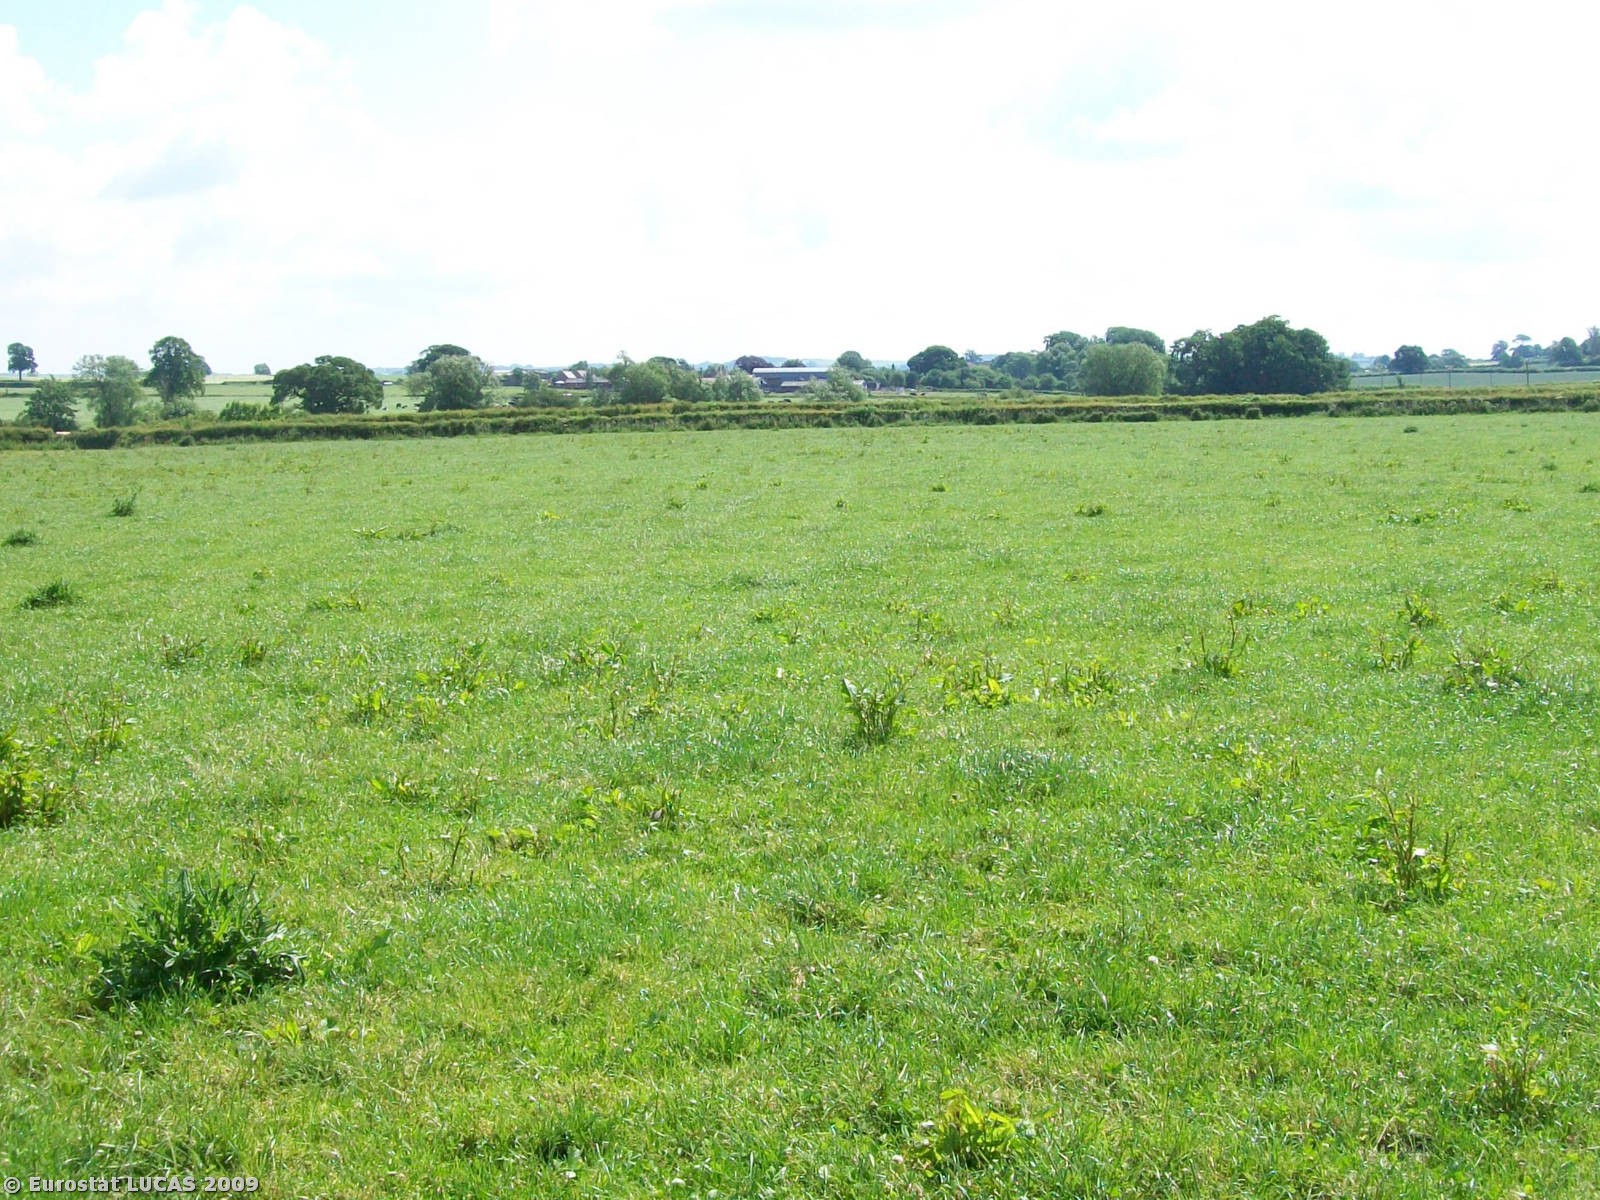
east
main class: Grassland
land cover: Grassland without tree/shrub cover
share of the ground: > 75 %
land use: Agriculture (excluding fallow land and kitchen gardens)
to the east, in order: Grassland without tree/shrub cover; Managed hedges; Grassland without tree/shrub cover
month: June
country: GB
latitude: 50.9698
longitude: -2.6430
